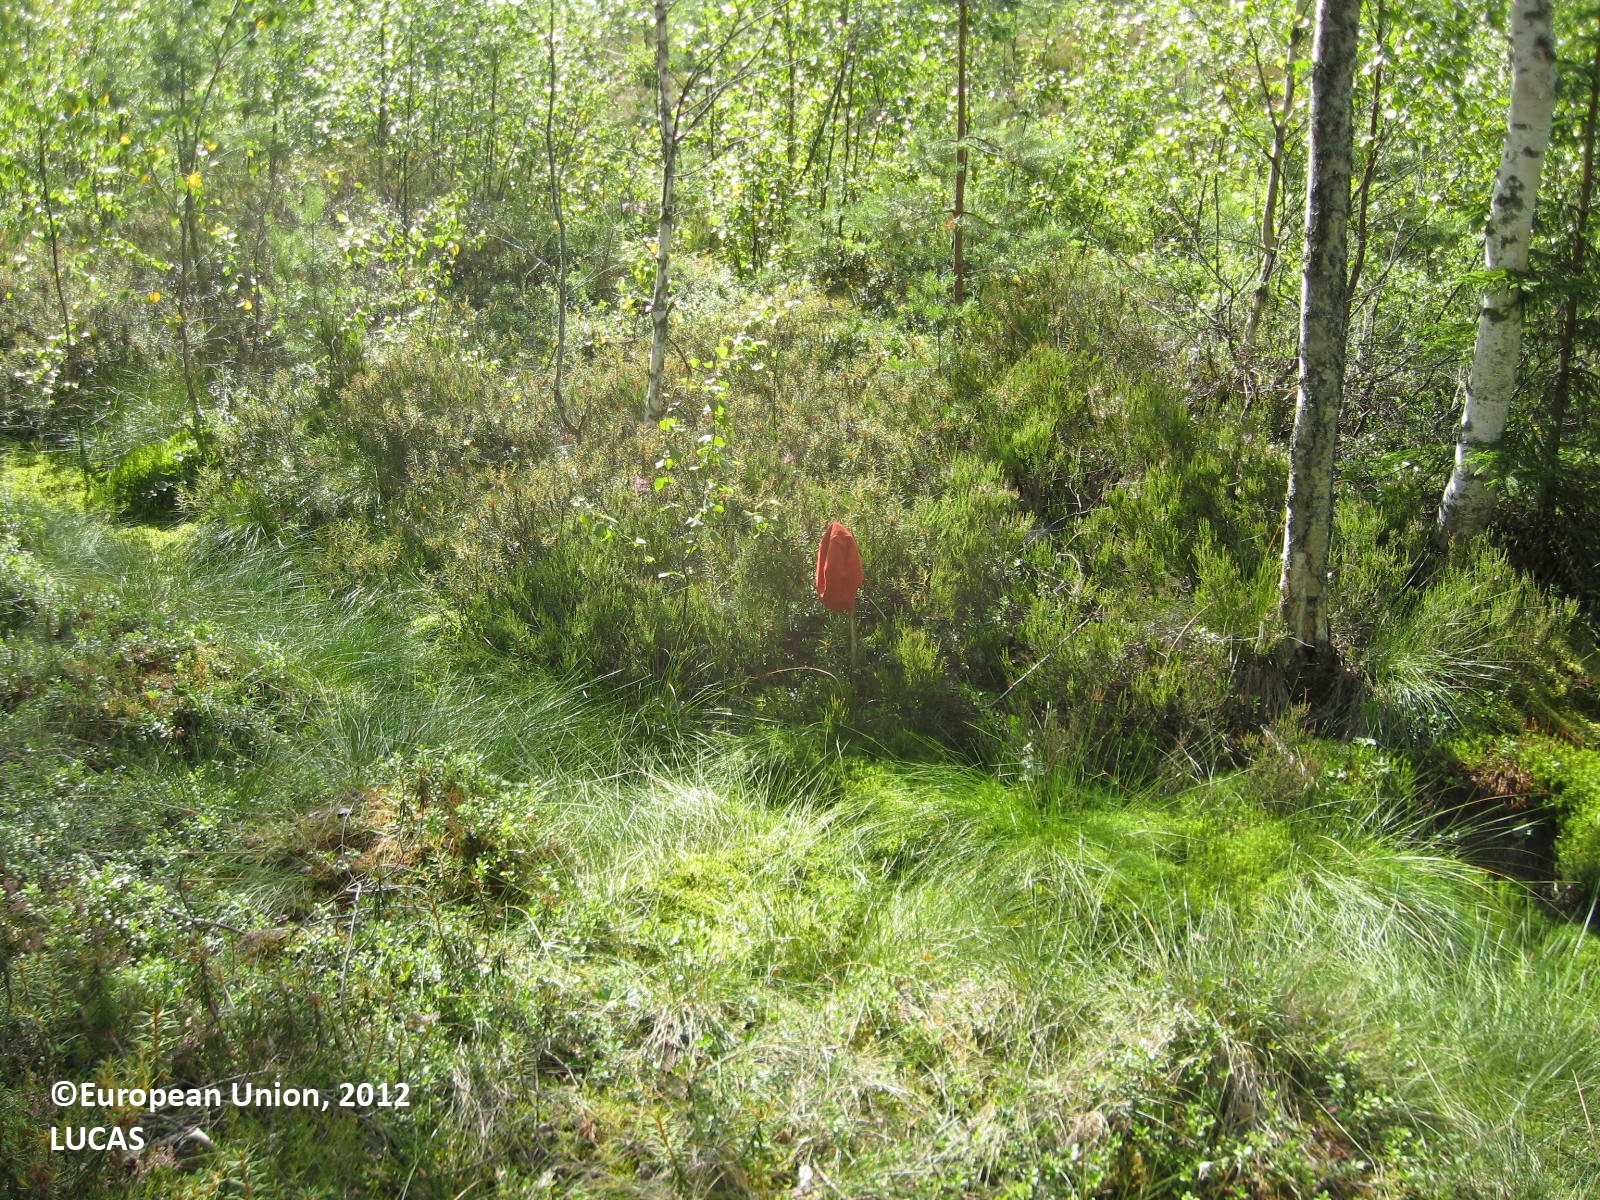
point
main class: Woodland
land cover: Pine dominated mixed woodland
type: boreal forest
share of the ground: > 75 %
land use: Forestry
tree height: > 5 m
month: July
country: FI
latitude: 62.0243
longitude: 22.6158
